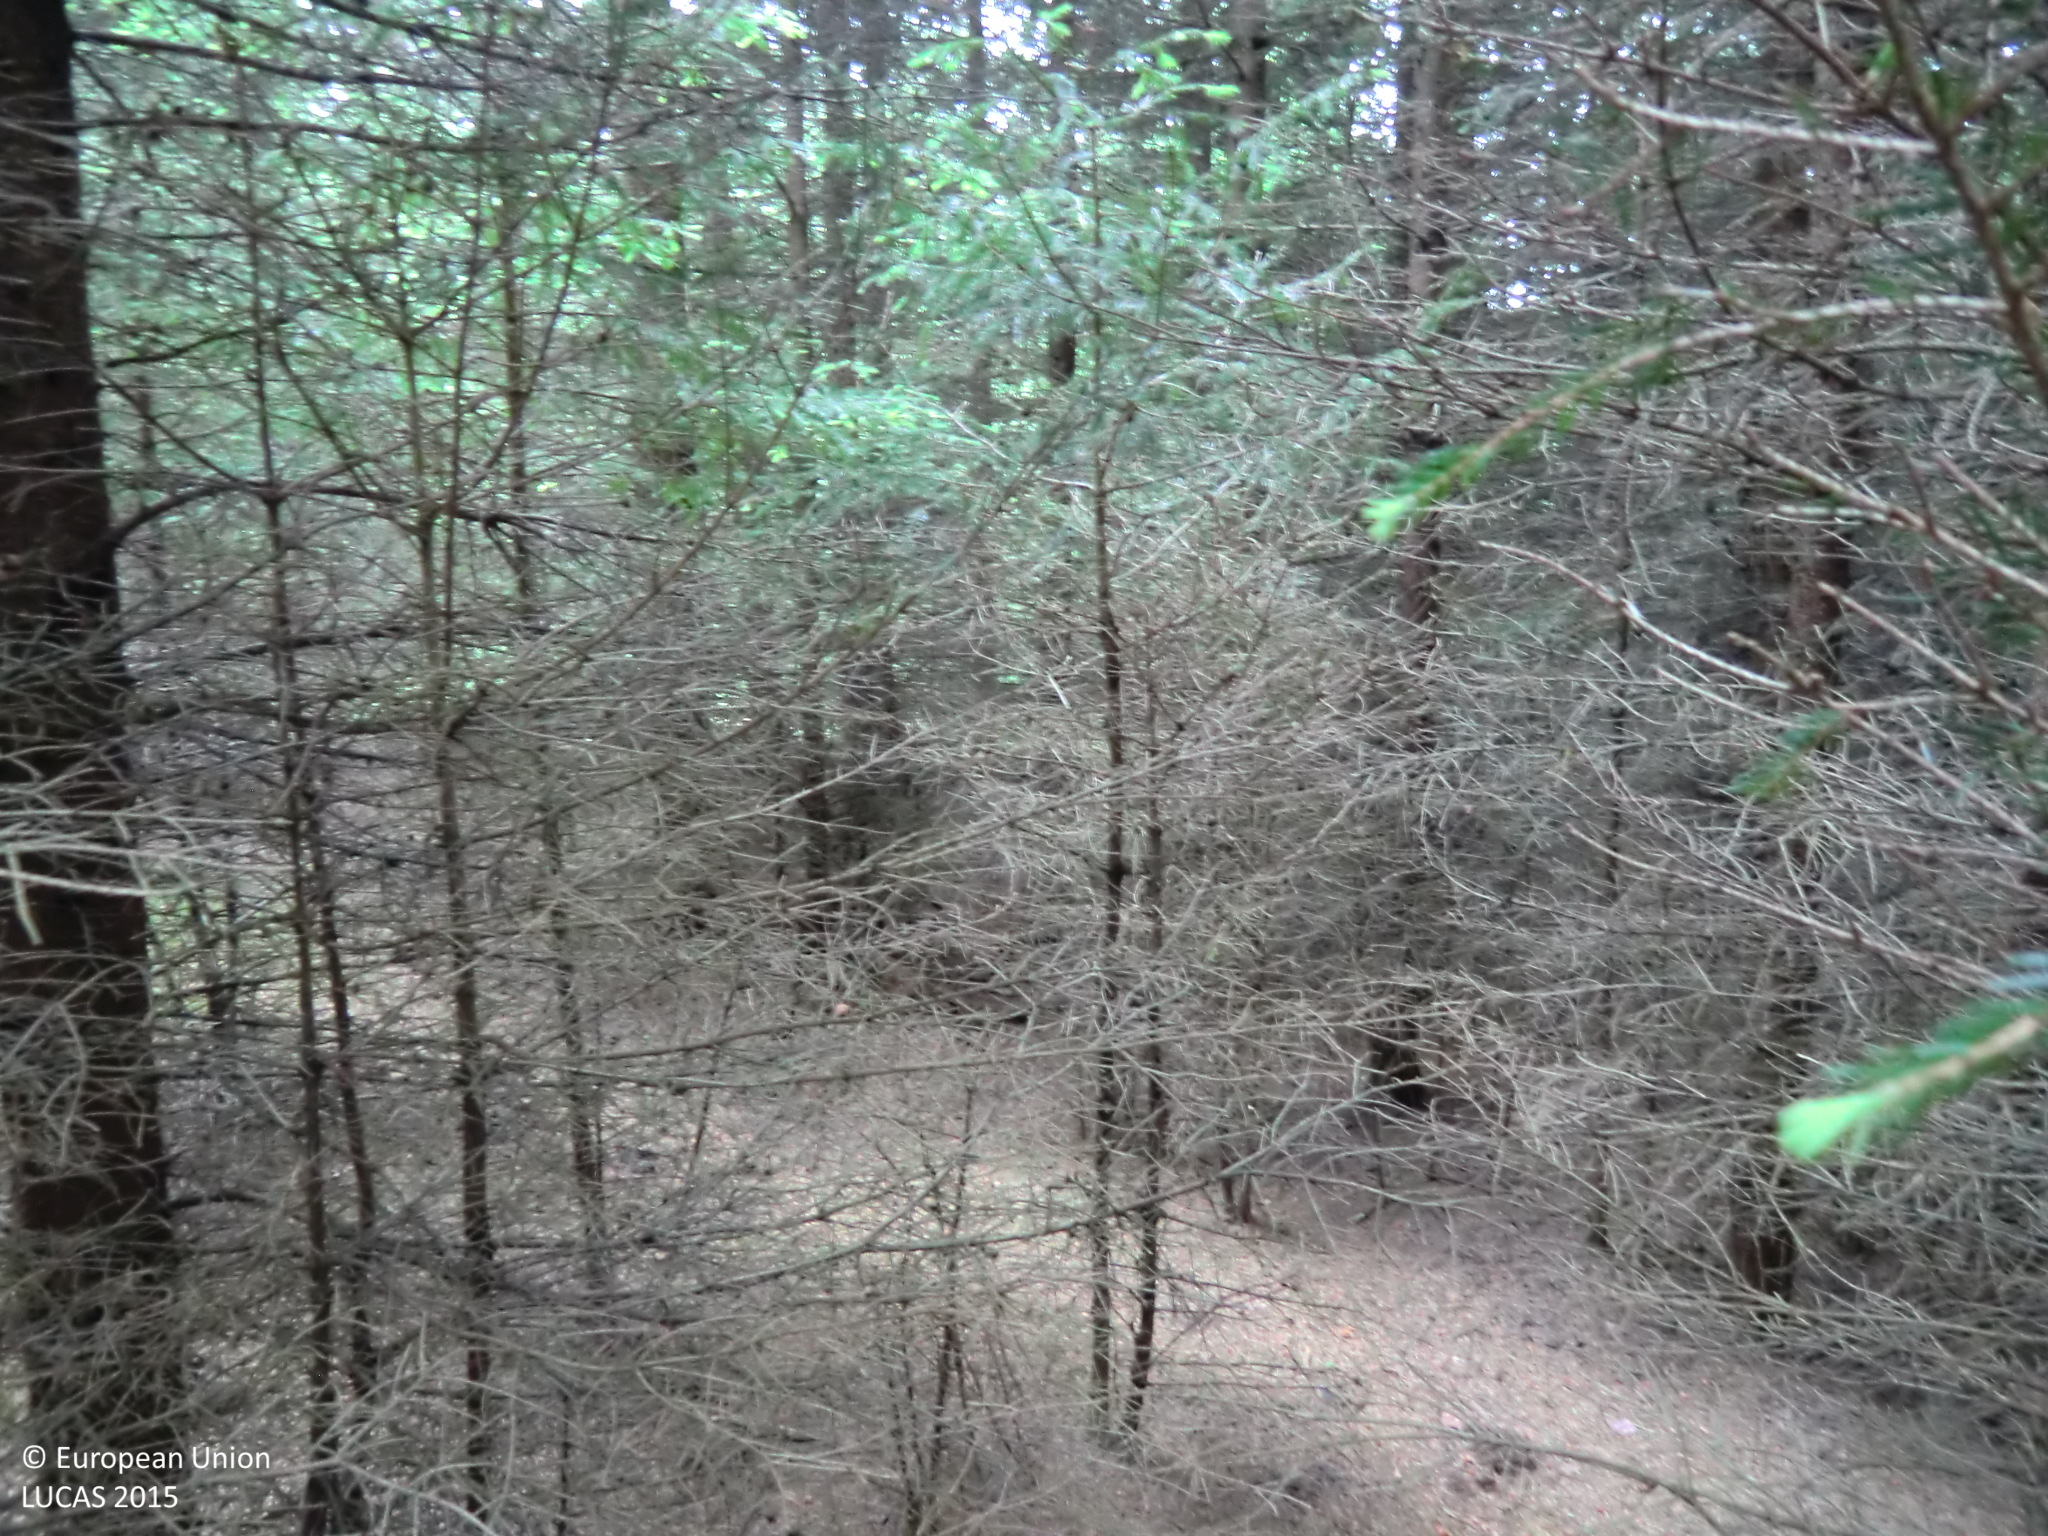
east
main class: Woodland
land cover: Spruce dominated coniferous woodland
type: hemiboreal forest and nemoral coniferous forest and mixed broadleaved-coniferous forest
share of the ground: > 75 %
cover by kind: coniferous forest trees 90 %, unconsolidated bare surface 10 %
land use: Forestry
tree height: > 5 m
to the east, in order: Spruce dominated coniferous woodland; Tracks; Spruce dominated coniferous woodland; Rivers and streams; Spruce dominated coniferous woodland
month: June
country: AT
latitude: 48.5954
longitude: 15.0322
